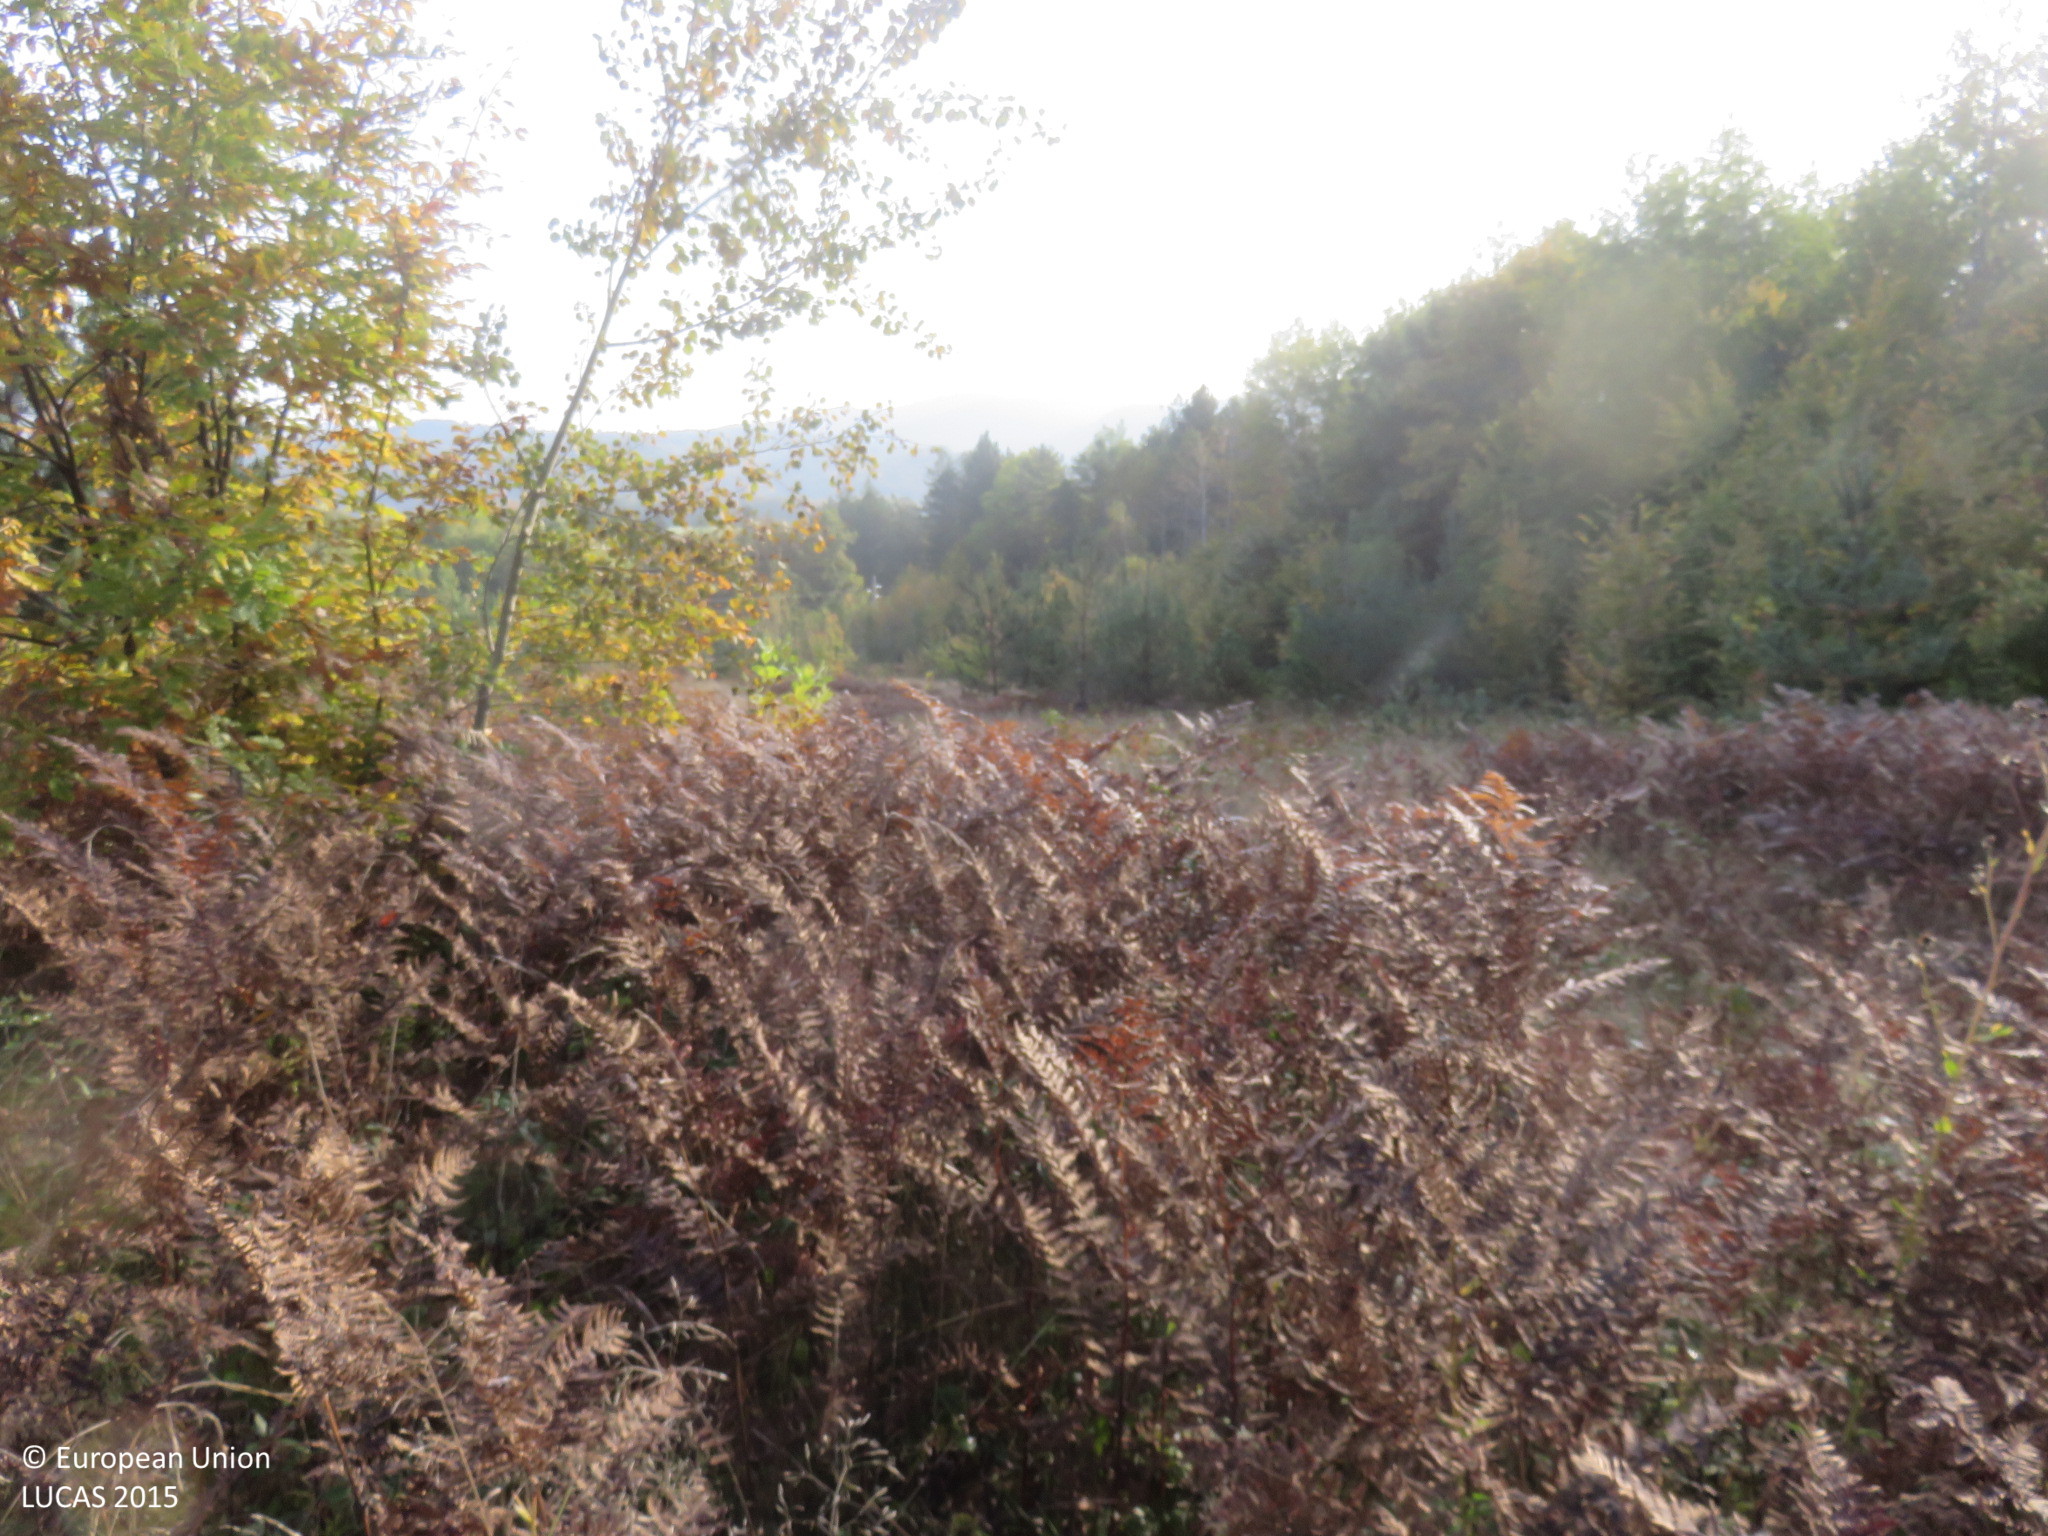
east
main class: Grassland
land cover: Grassland with sparse tree/shrub cover
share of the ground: > 75 %
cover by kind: herbaceous plants 90 %, broadleaved forest trees 5 %, shrubs 5 %
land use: Abandoned areas
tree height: < 5 m
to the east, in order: Grassland with sparse tree/shrub cover; Shrubland with sparse tree cover; Other mixed woodland
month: October
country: BG
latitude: 42.8951
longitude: 24.8175
